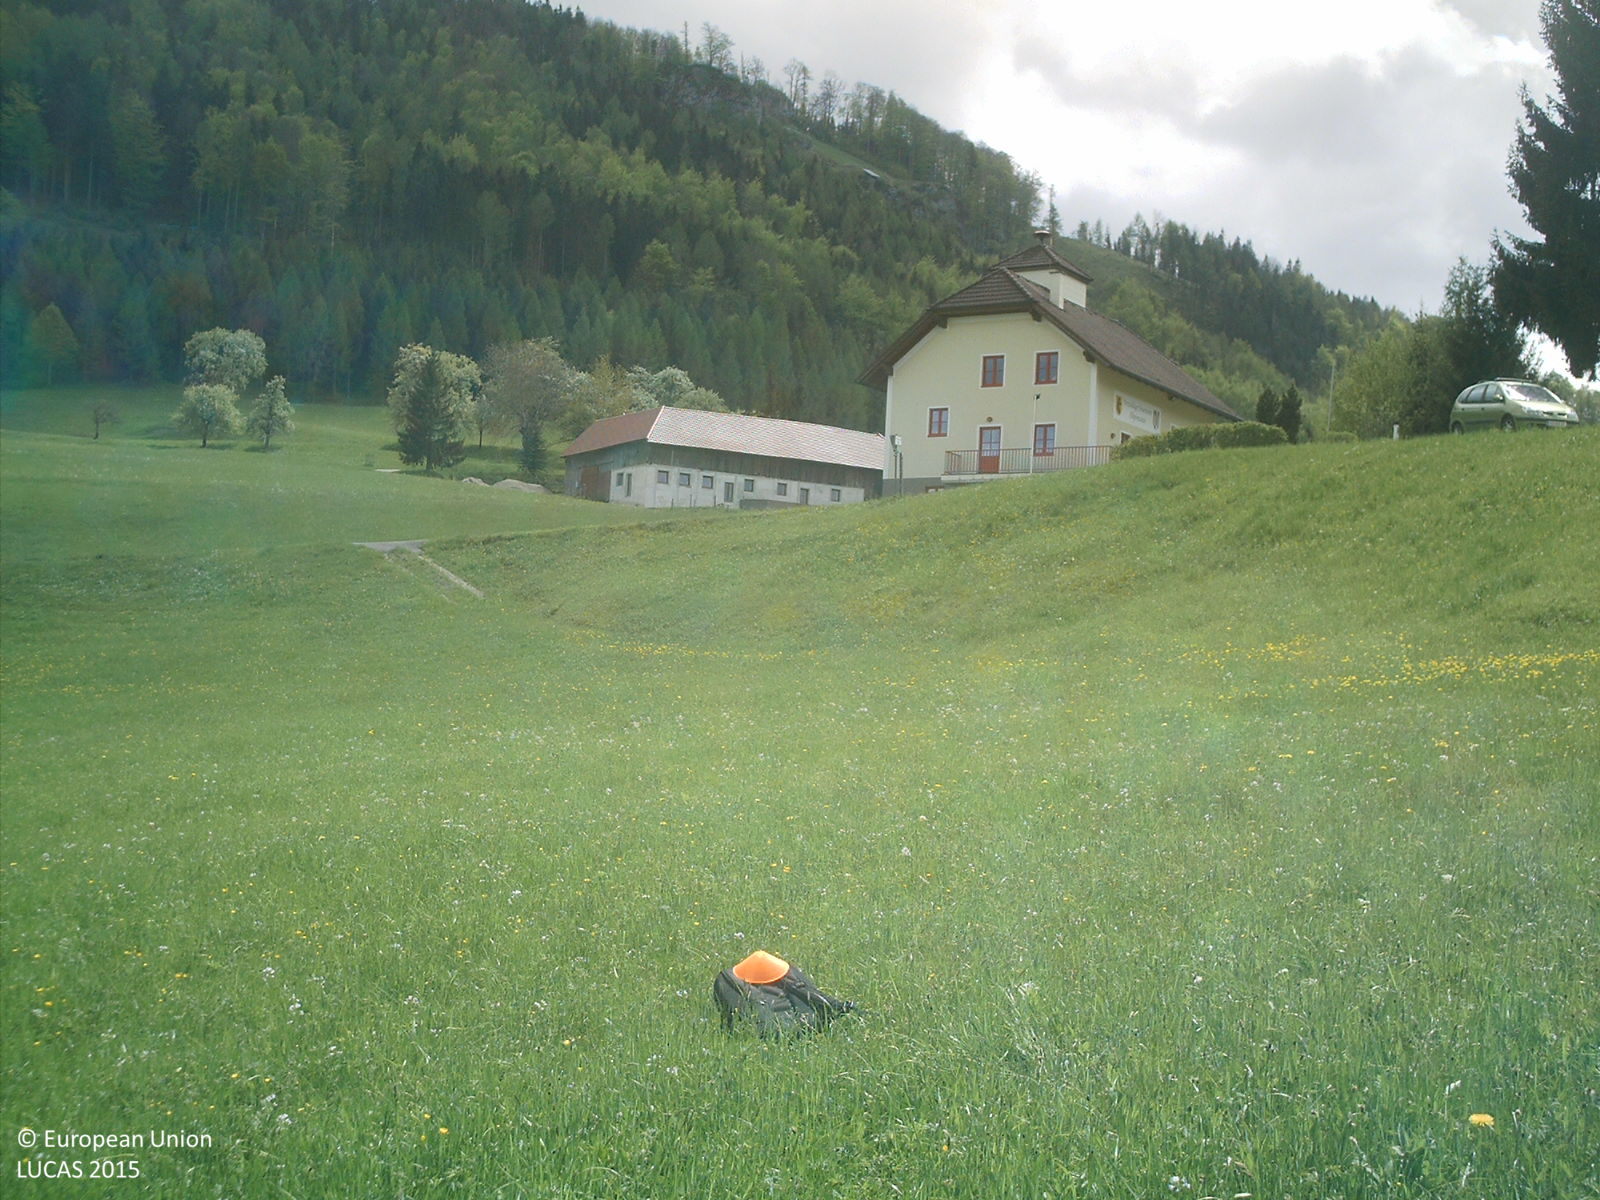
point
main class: Grassland
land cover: Grassland without tree/shrub cover
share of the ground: > 75 %
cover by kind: herbaceous plants 100 %
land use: Agriculture (excluding fallow land and kitchen gardens)
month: May
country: AT
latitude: 47.8928
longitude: 14.1591
